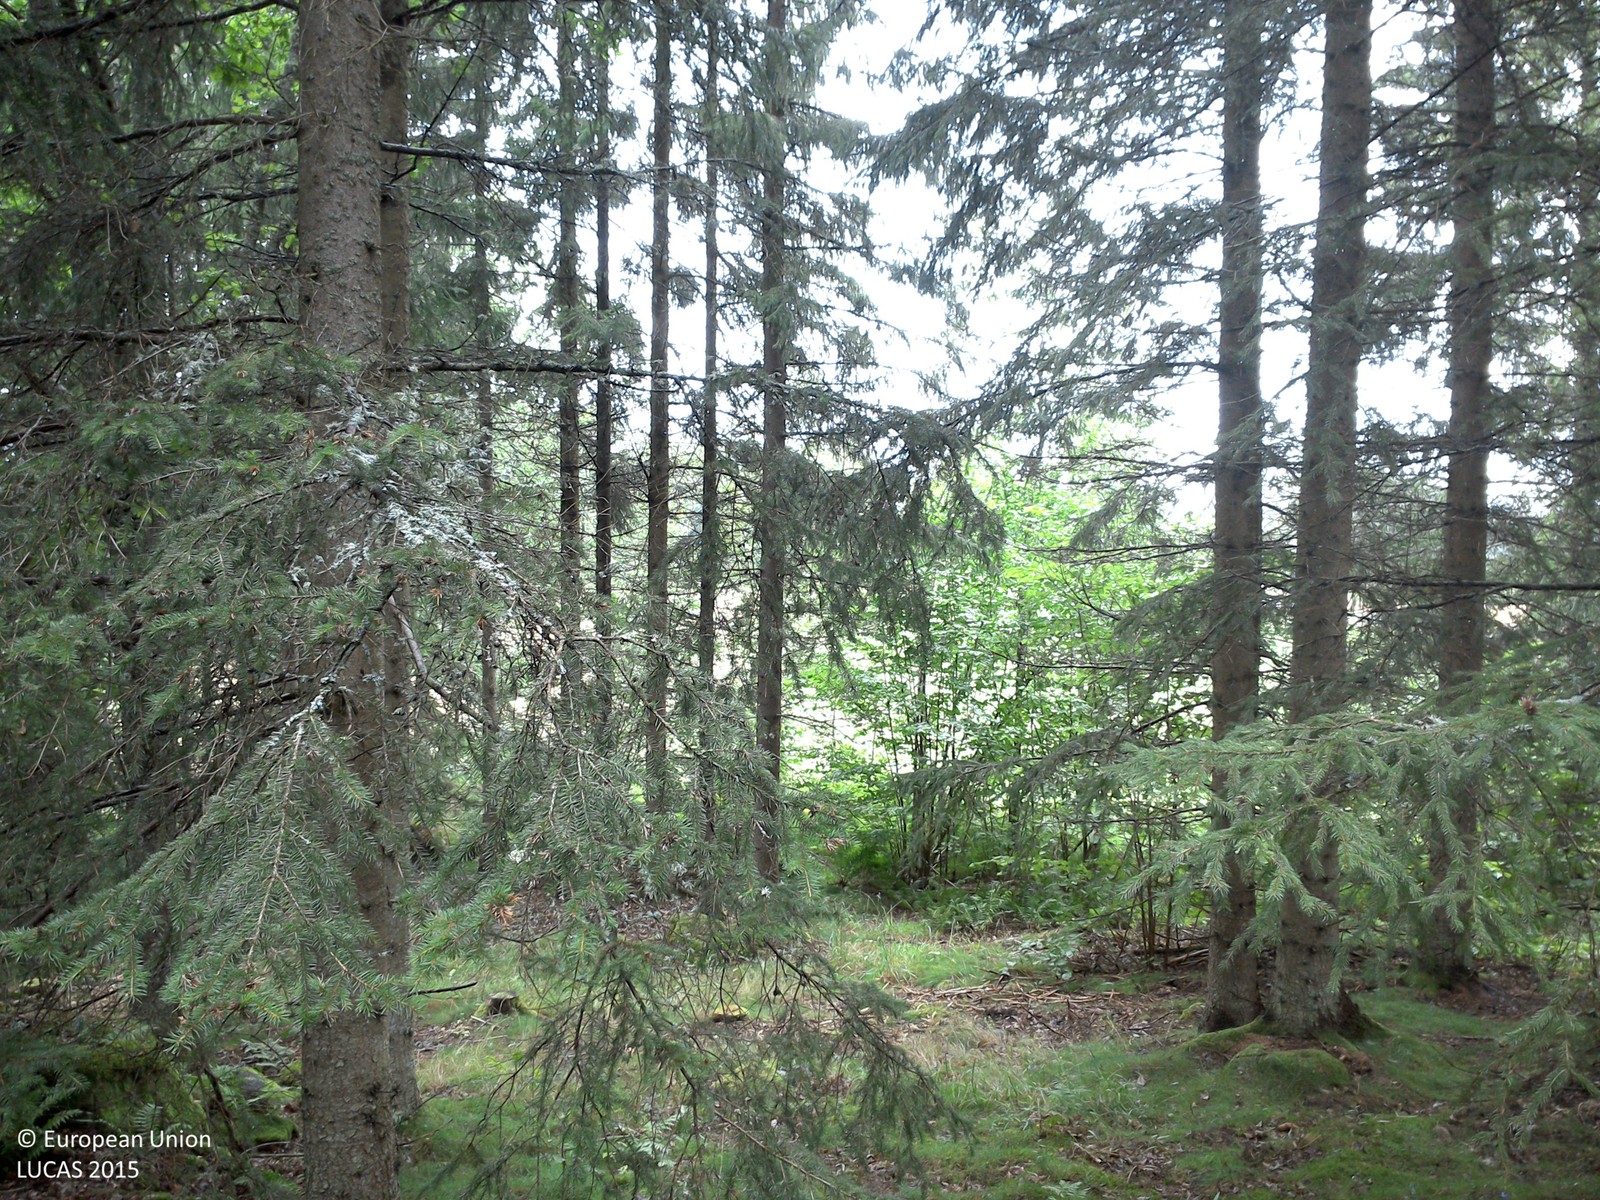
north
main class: Woodland
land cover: Spruce dominated coniferous woodland
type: boreal forest
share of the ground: 50 - 75 %
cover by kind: coniferous forest trees 60 %, herbaceous plants 40 %
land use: Forestry
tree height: > 5 m
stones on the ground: < 10 %
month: August
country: SE
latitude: 58.2527
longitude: 15.4645
